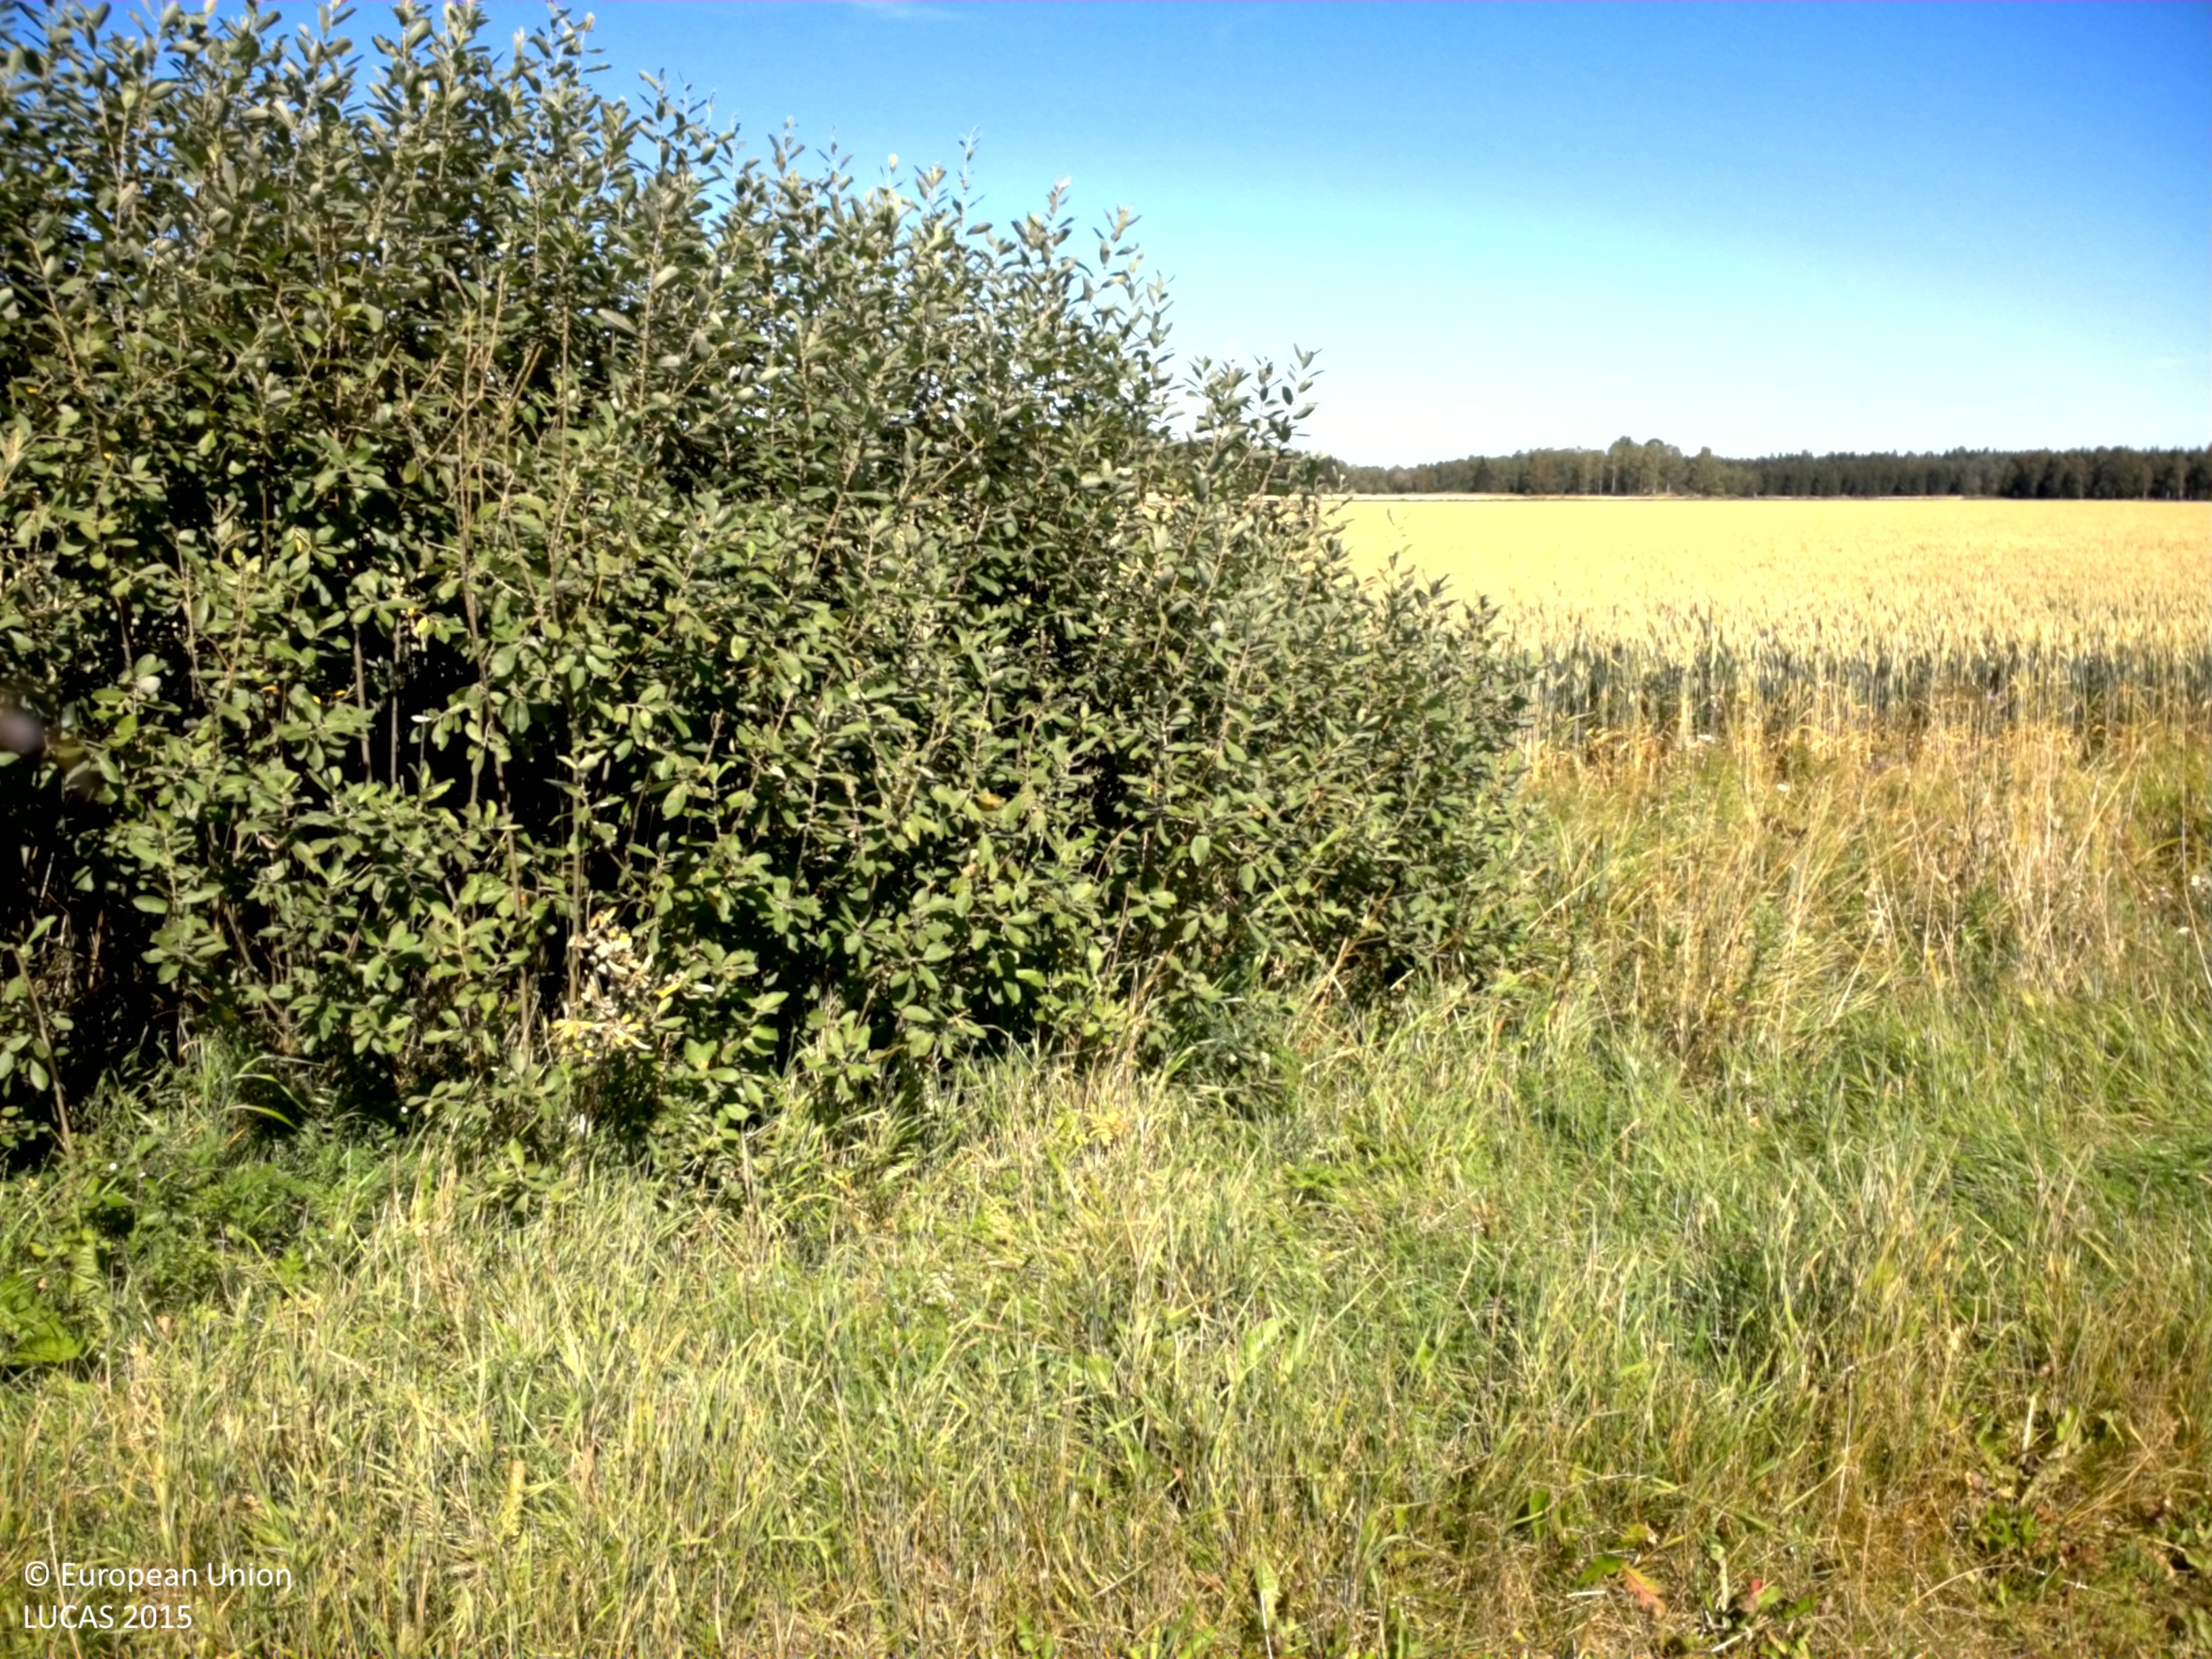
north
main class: Cropland
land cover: Common wheat
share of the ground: > 75 %
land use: Agriculture (excluding fallow land and kitchen gardens)
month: August
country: SE
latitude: 60.1301
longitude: 17.0657
